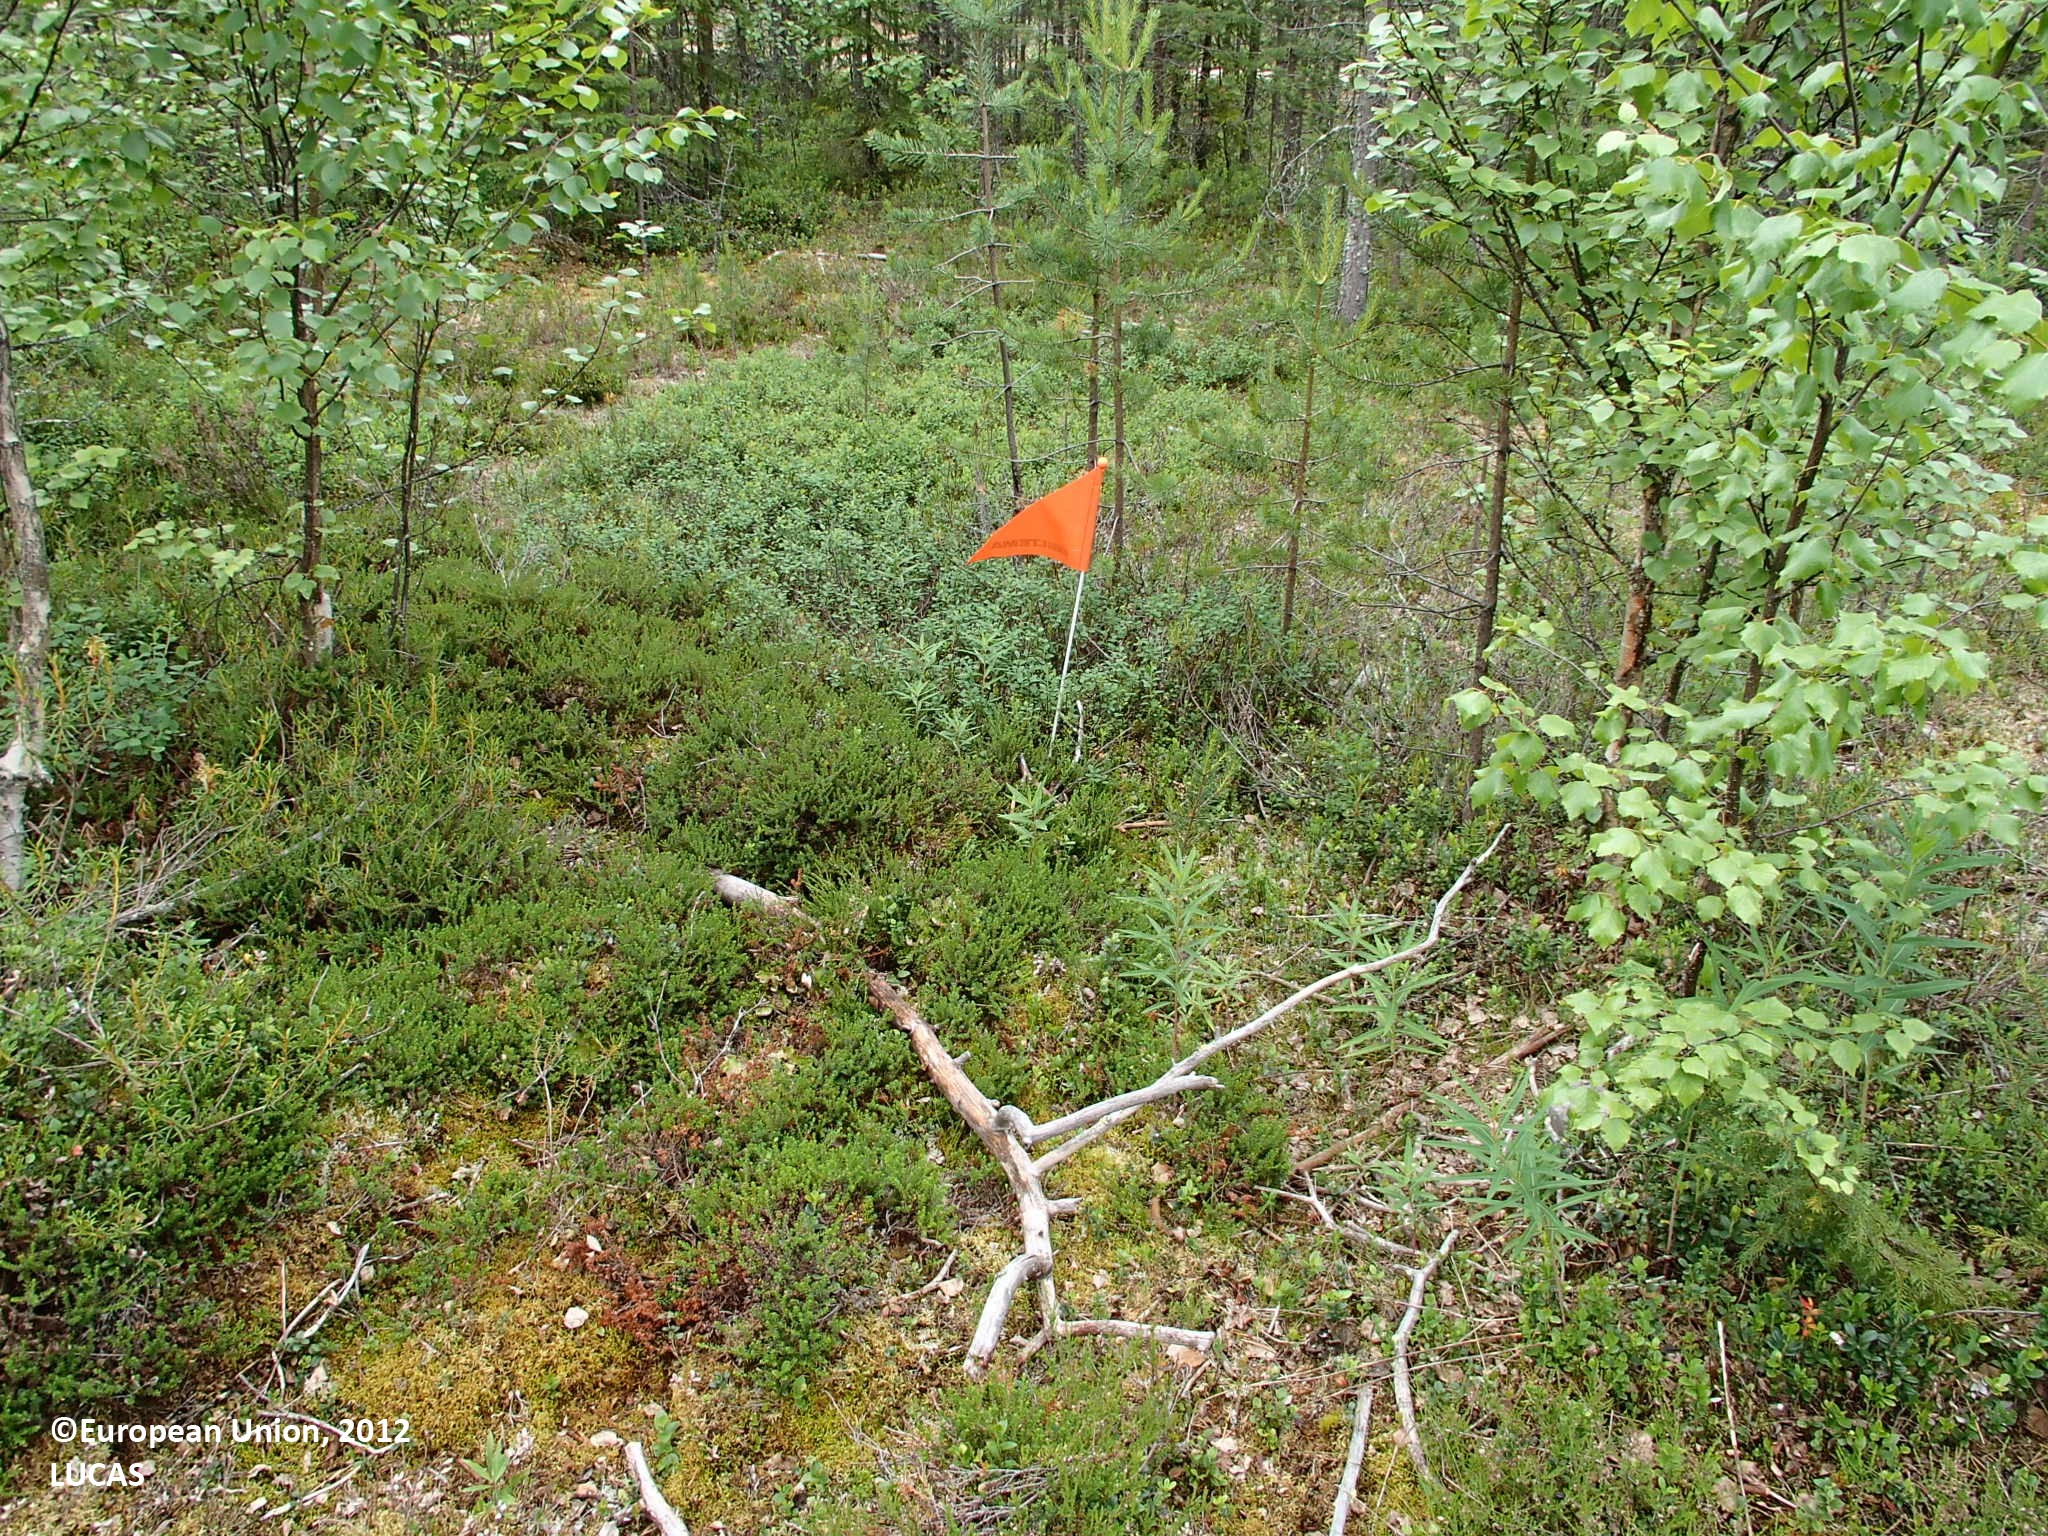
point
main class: Woodland
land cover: Other mixed woodland
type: boreal forest
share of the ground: 50 - 75 %
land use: Forestry
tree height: > 5 m
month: July
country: FI
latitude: 66.9170
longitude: 25.3925
